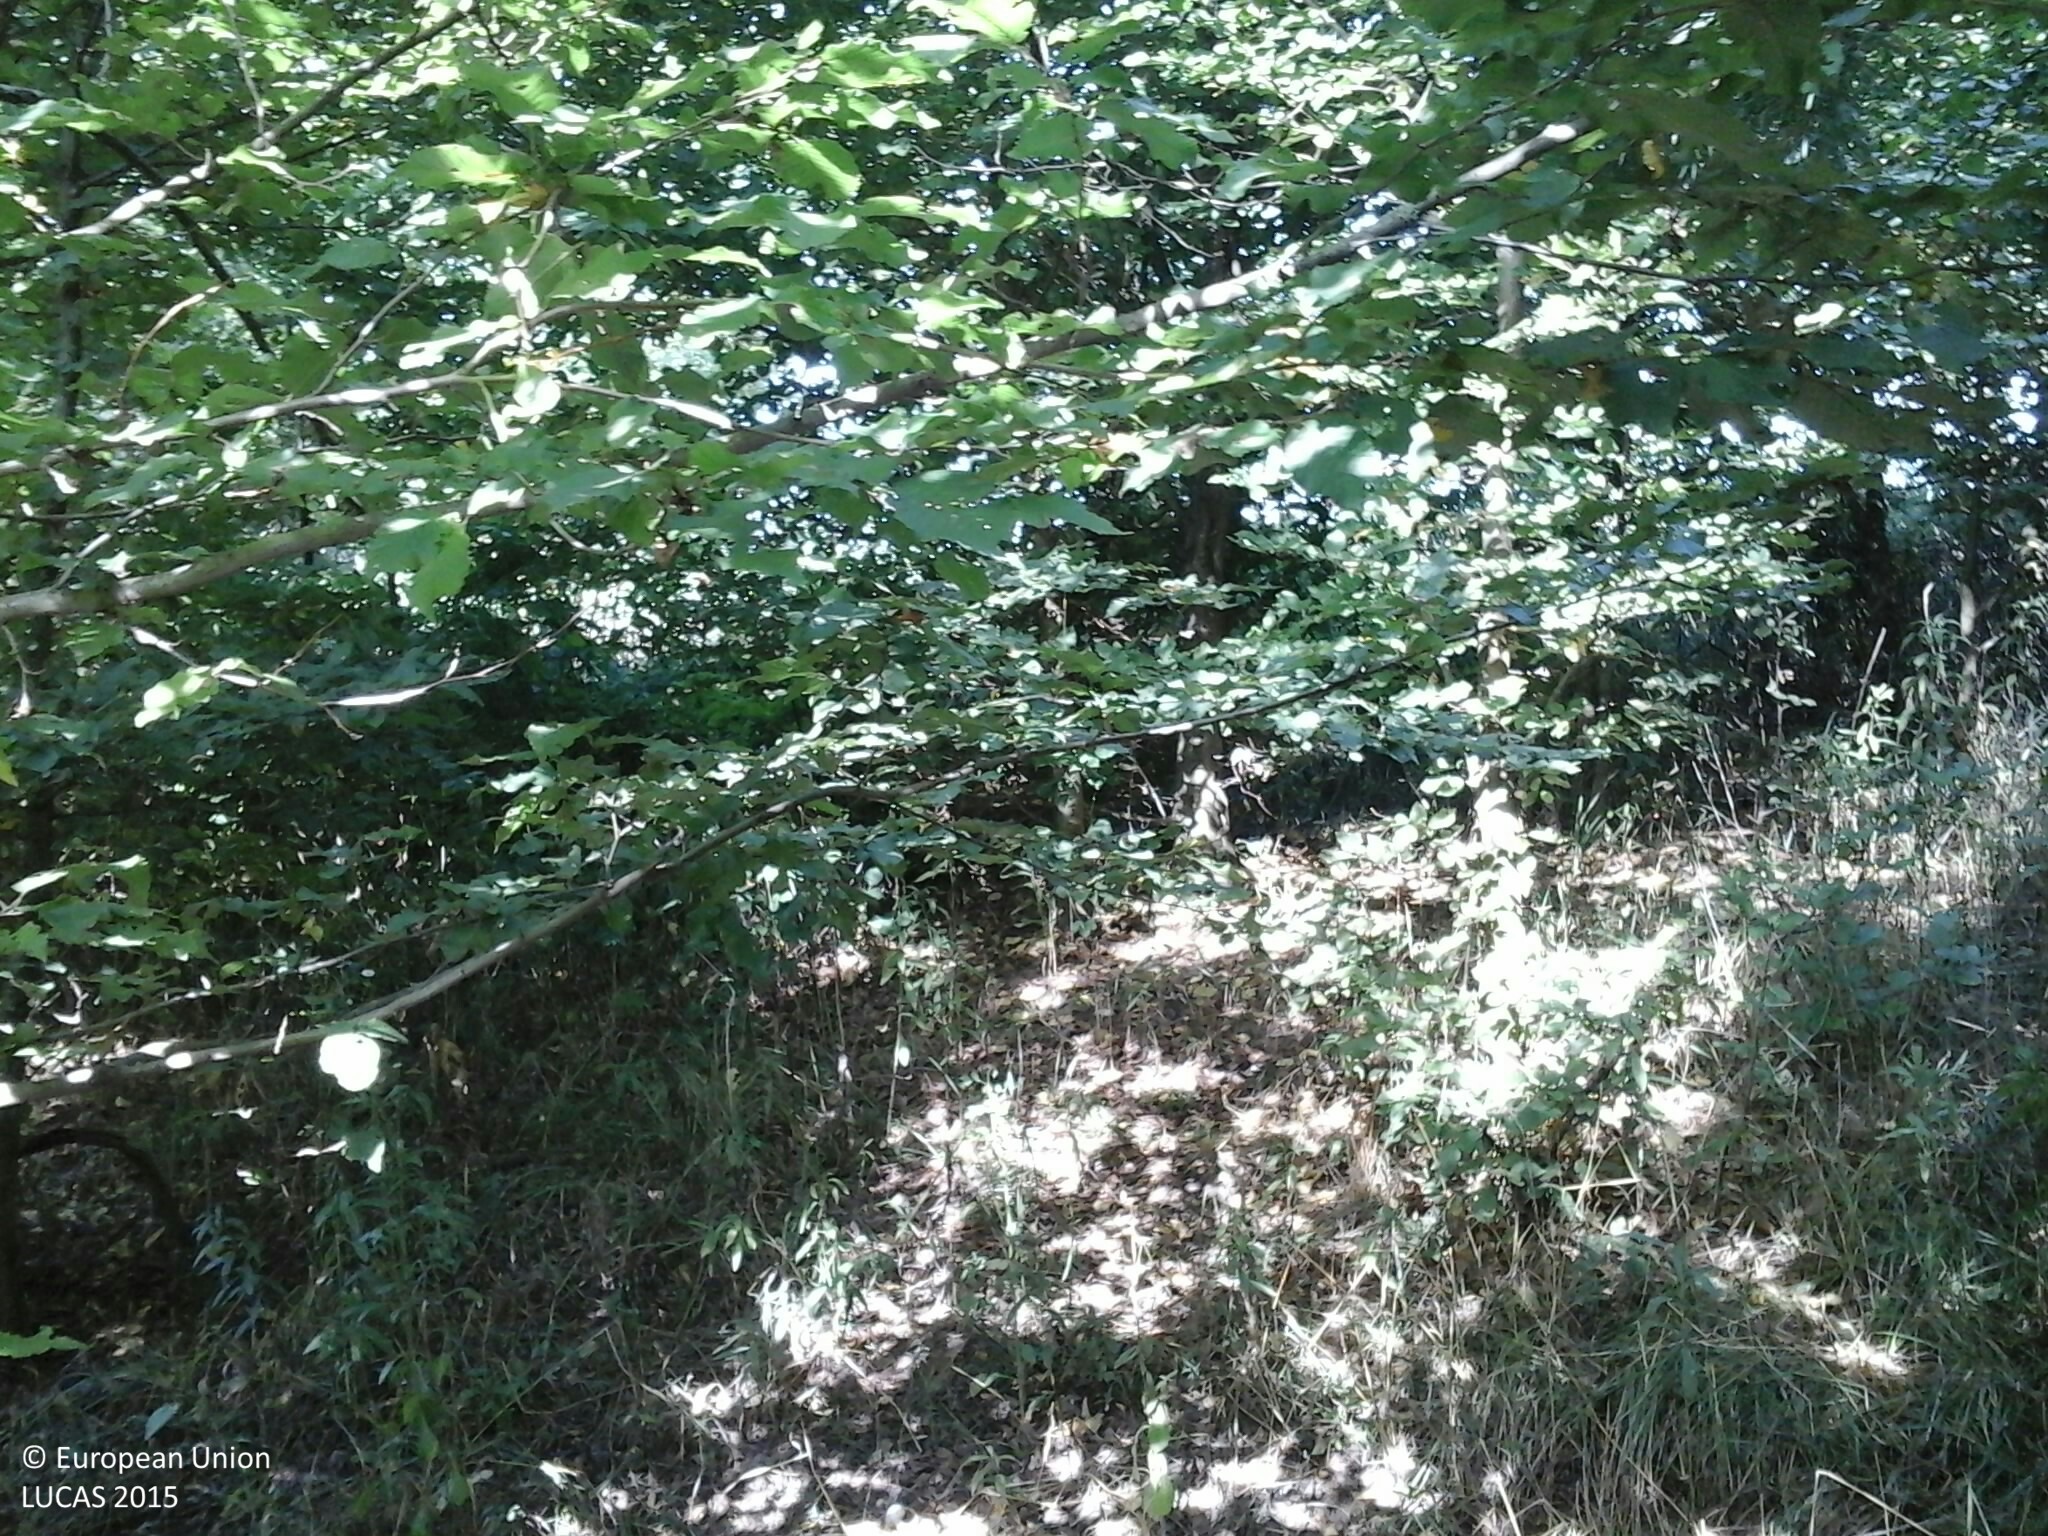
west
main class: Woodland
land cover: Pine dominated mixed woodland
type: hemiboreal forest and nemoral coniferous forest and mixed broadleaved-coniferous forest
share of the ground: > 75 %
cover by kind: coniferous forest trees 50 %, broadleaved forest trees 30 %, shrubs 10 %, herbaceous plants 10 %
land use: Semi-natural and natural areas not in use
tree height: > 5 m
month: August
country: HU
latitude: 46.9204
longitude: 16.6606
